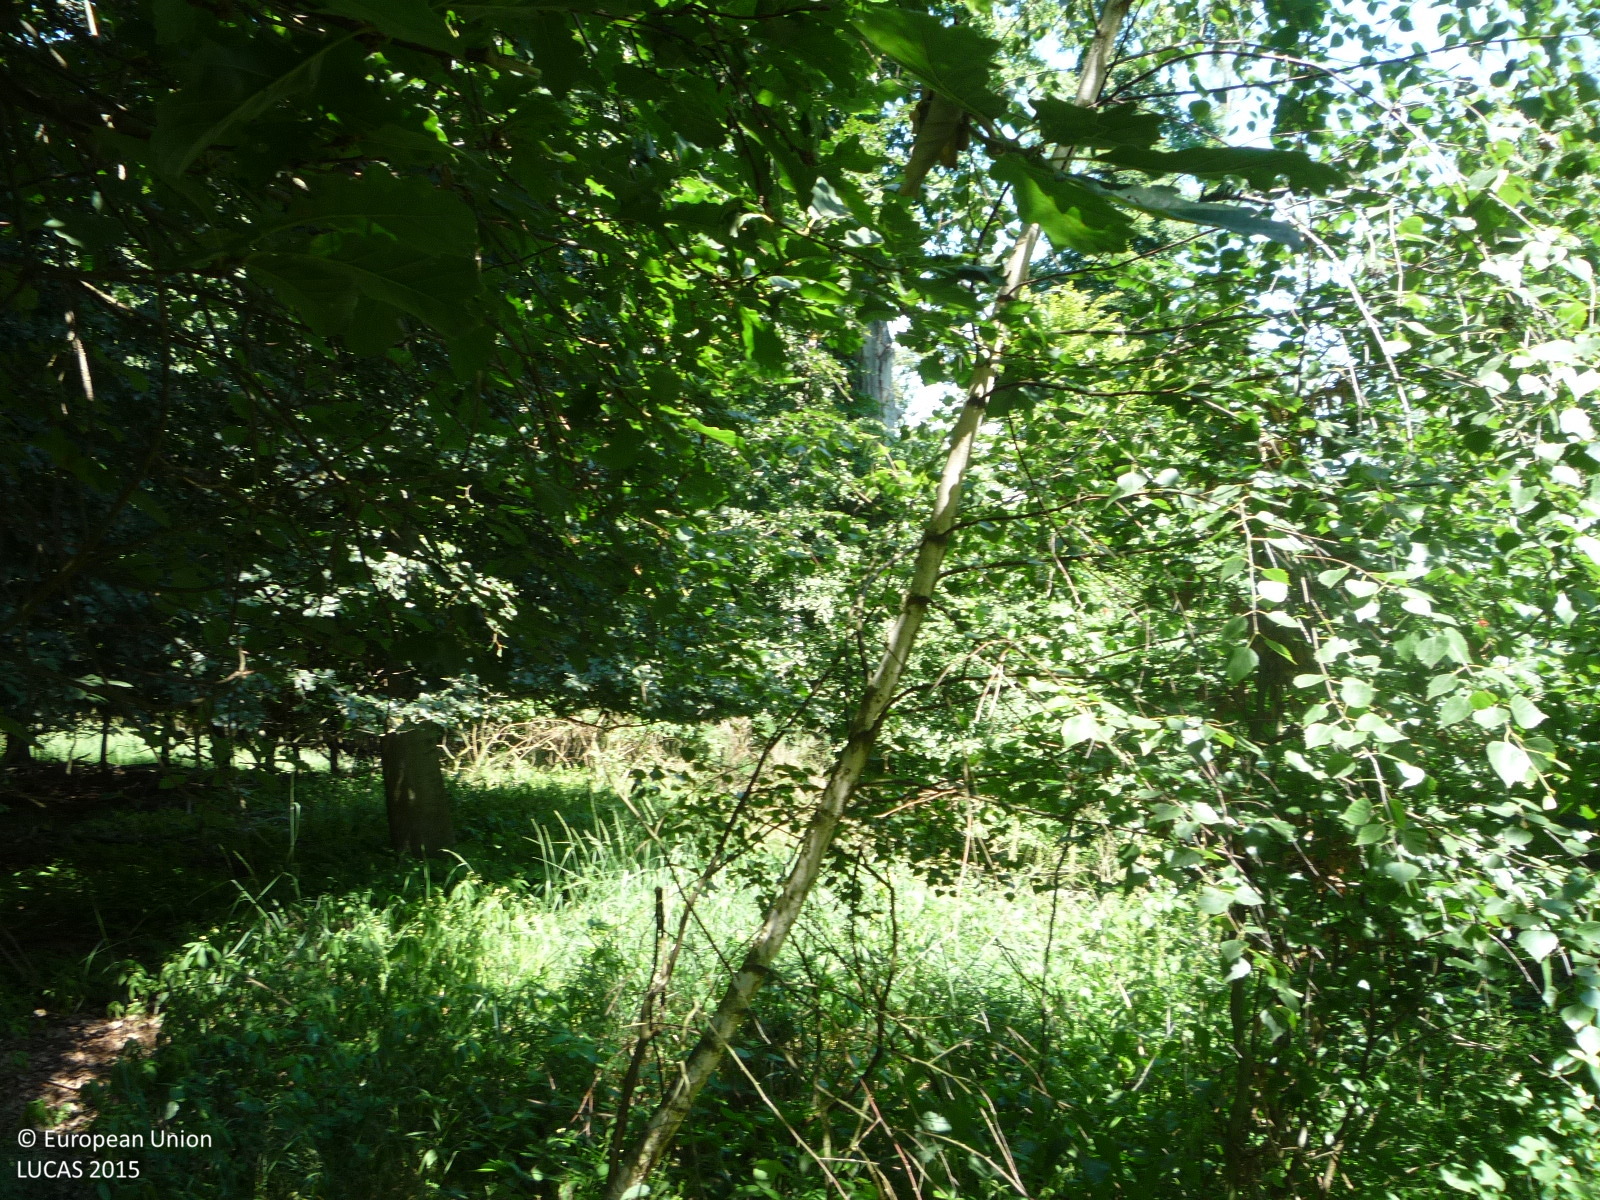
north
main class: Woodland
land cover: Broadleaved woodland
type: mesophytic deciduous forest
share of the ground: > 75 %
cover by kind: broadleaved forest trees 85 %, shrubs 10 %, herbaceous plants 5 %
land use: Semi-natural and natural areas not in use
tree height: > 5 m
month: July
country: CZ
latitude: 50.4200
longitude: 14.4915
